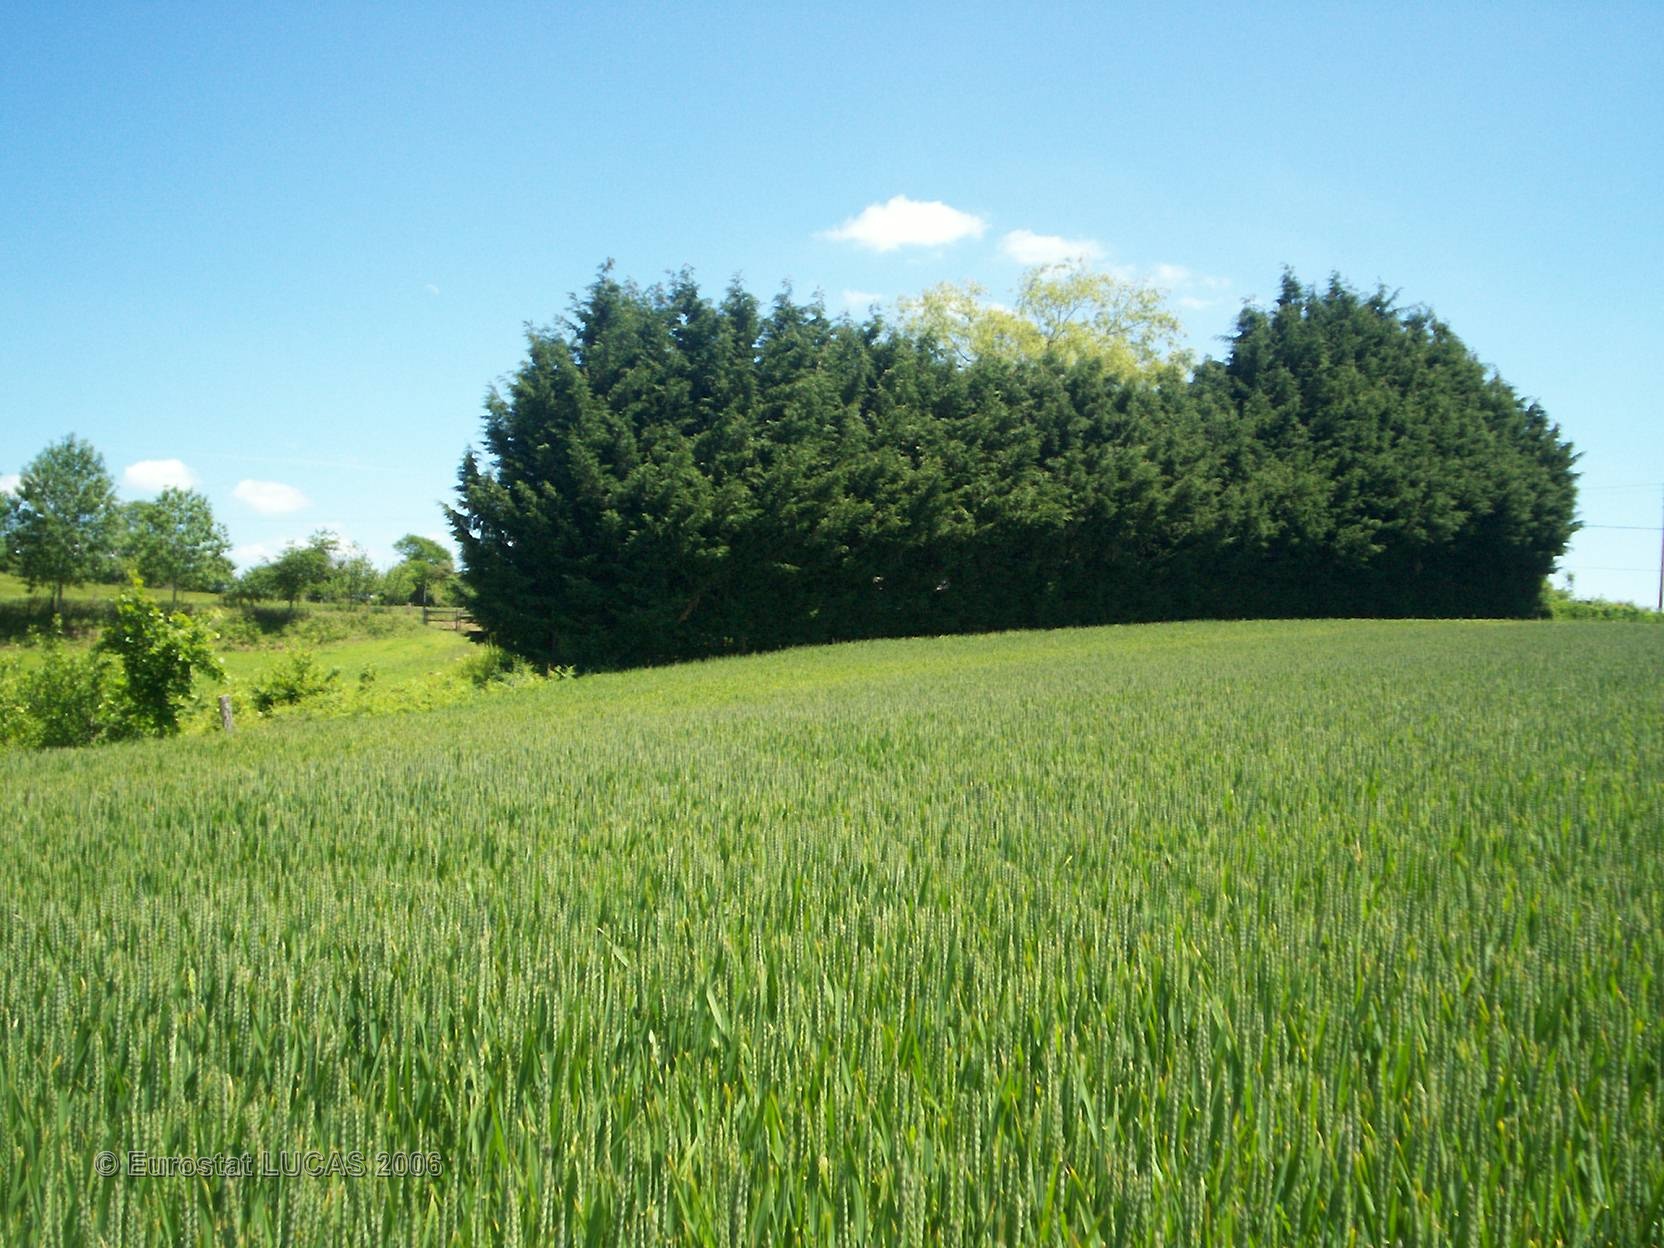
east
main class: Cropland
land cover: Common wheat
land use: Agriculture (excluding fallow land and kitchen gardens)
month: June
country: FR
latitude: 46.2581
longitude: 2.8753
